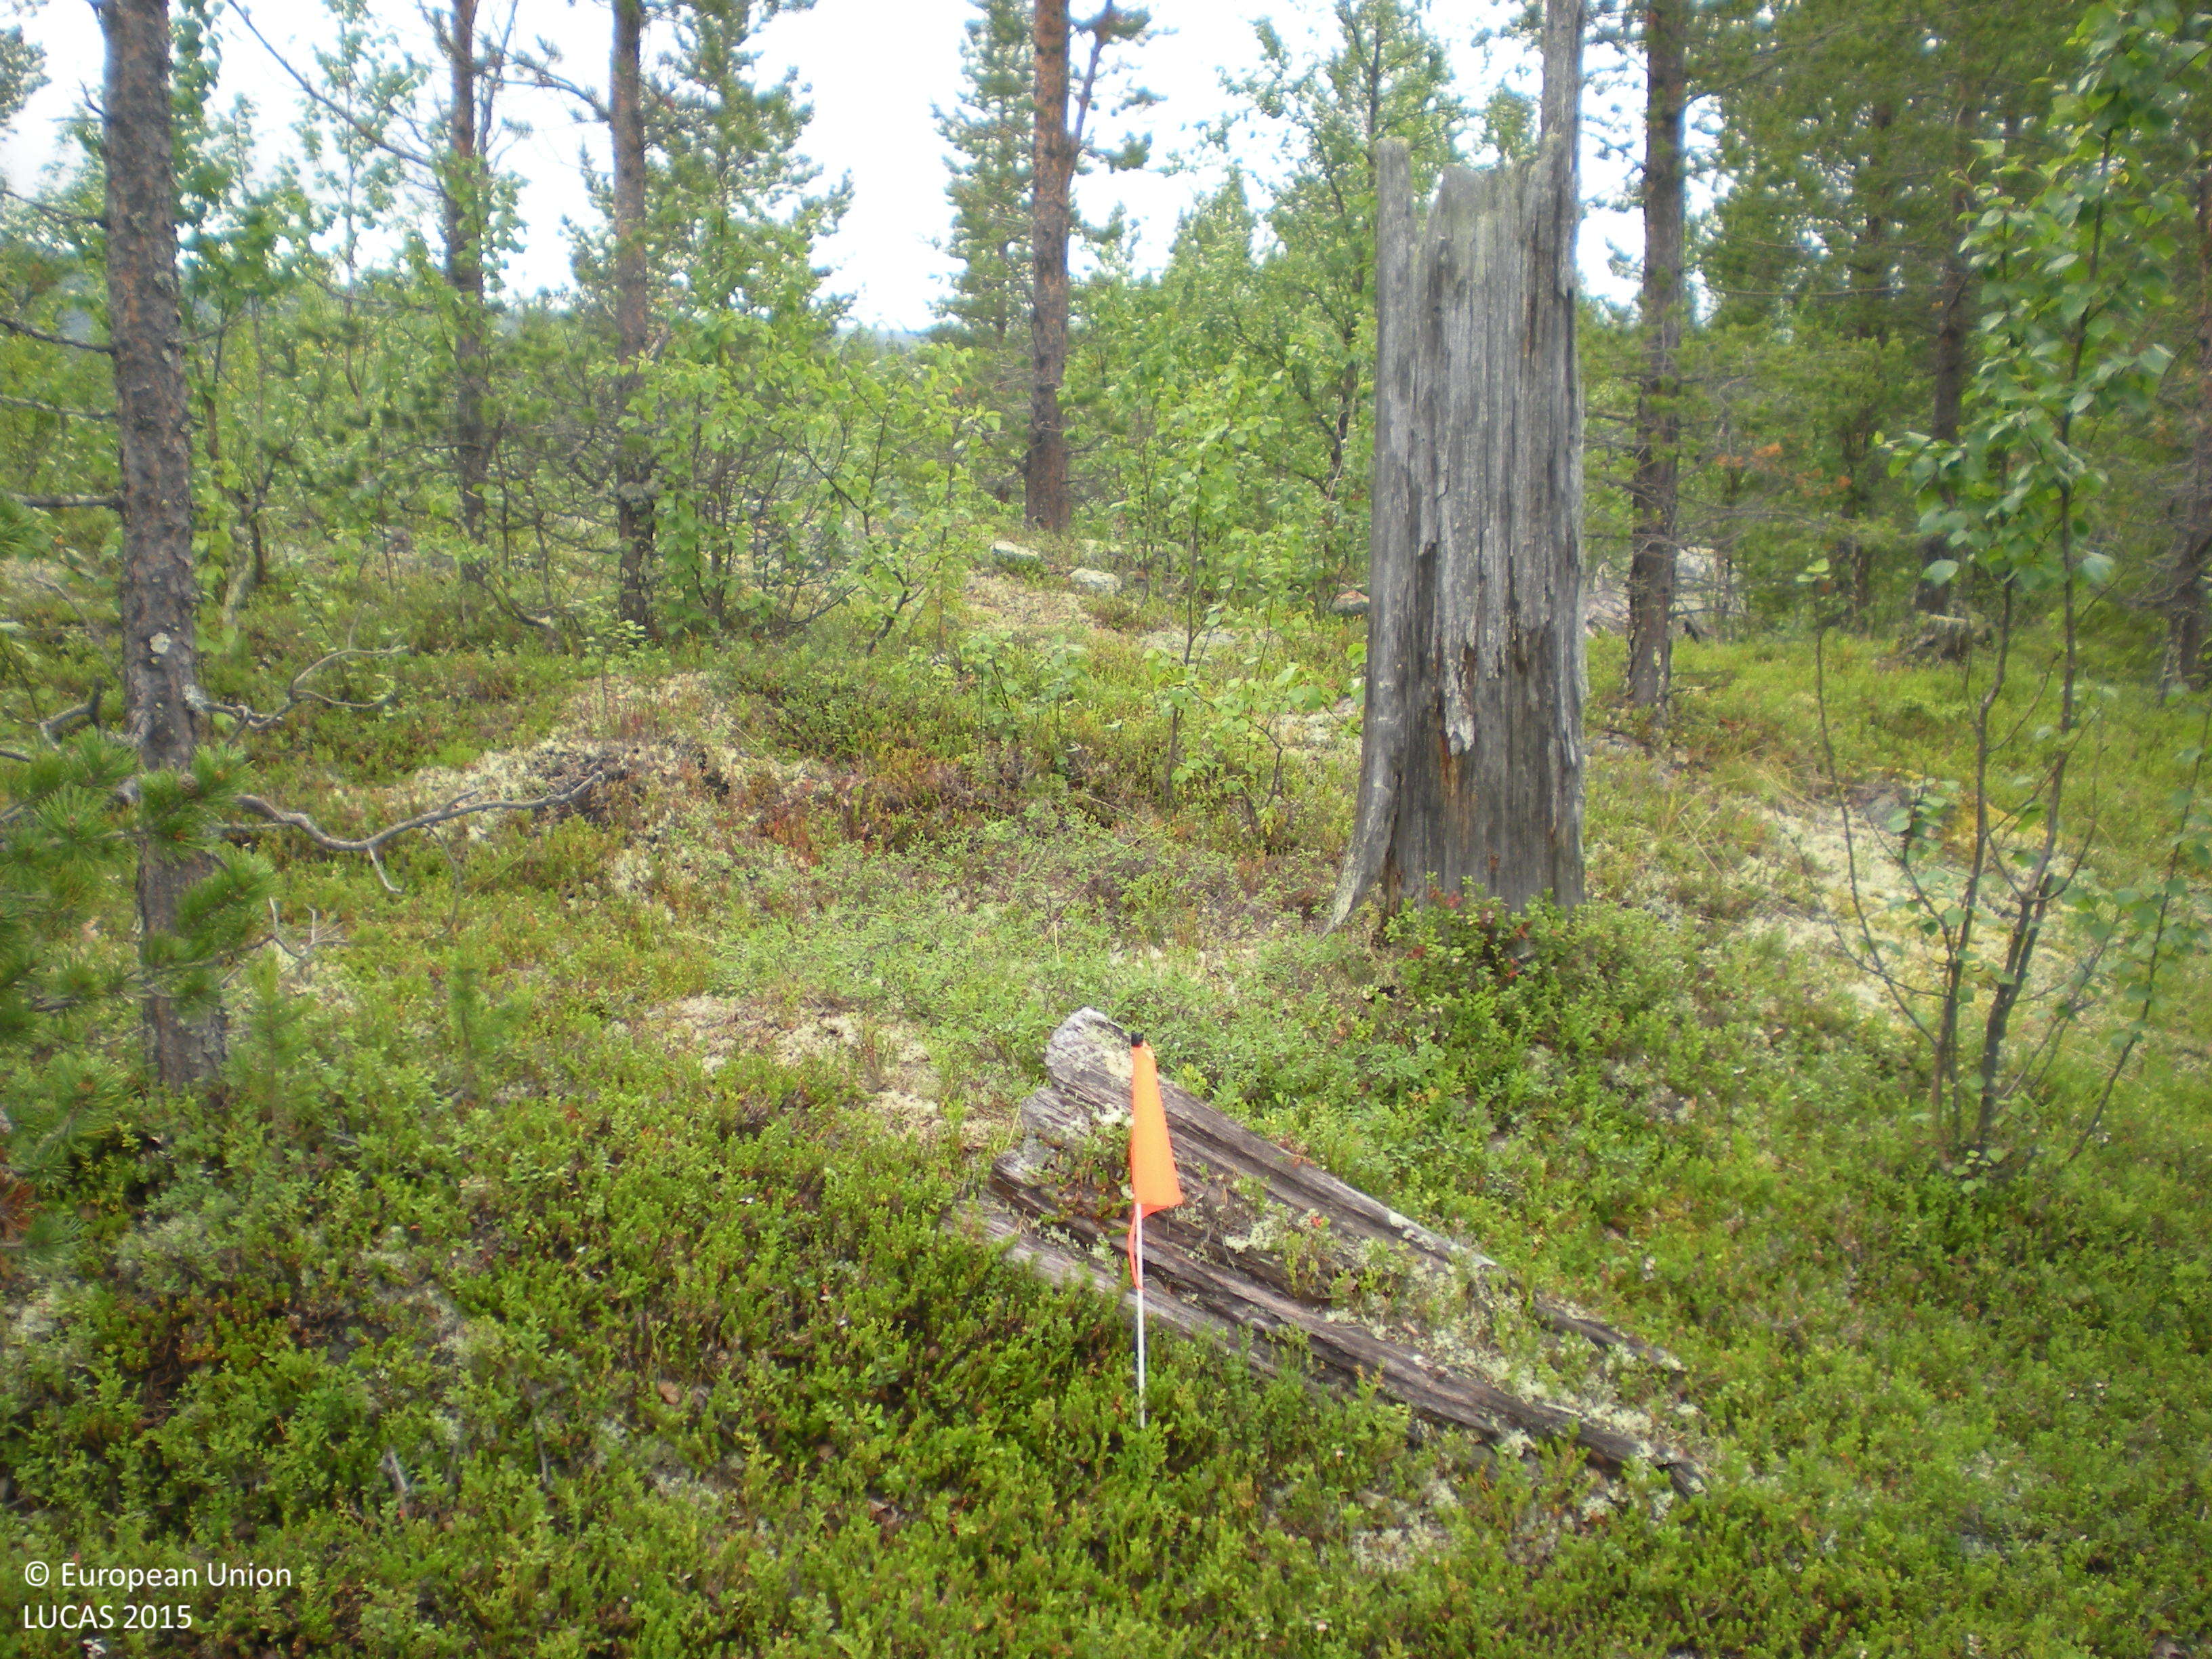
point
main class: Woodland
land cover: Pine dominated mixed woodland
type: boreal forest
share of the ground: 50 - 75 %
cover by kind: coniferous forest trees 45 %, shrubs 20 %, broadleaved forest trees 15 %, lichens and mosses 10 %, consolidated bare surface 10 %
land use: Forestry
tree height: > 5 m
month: August
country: SE
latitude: 66.2134
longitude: 18.0192
